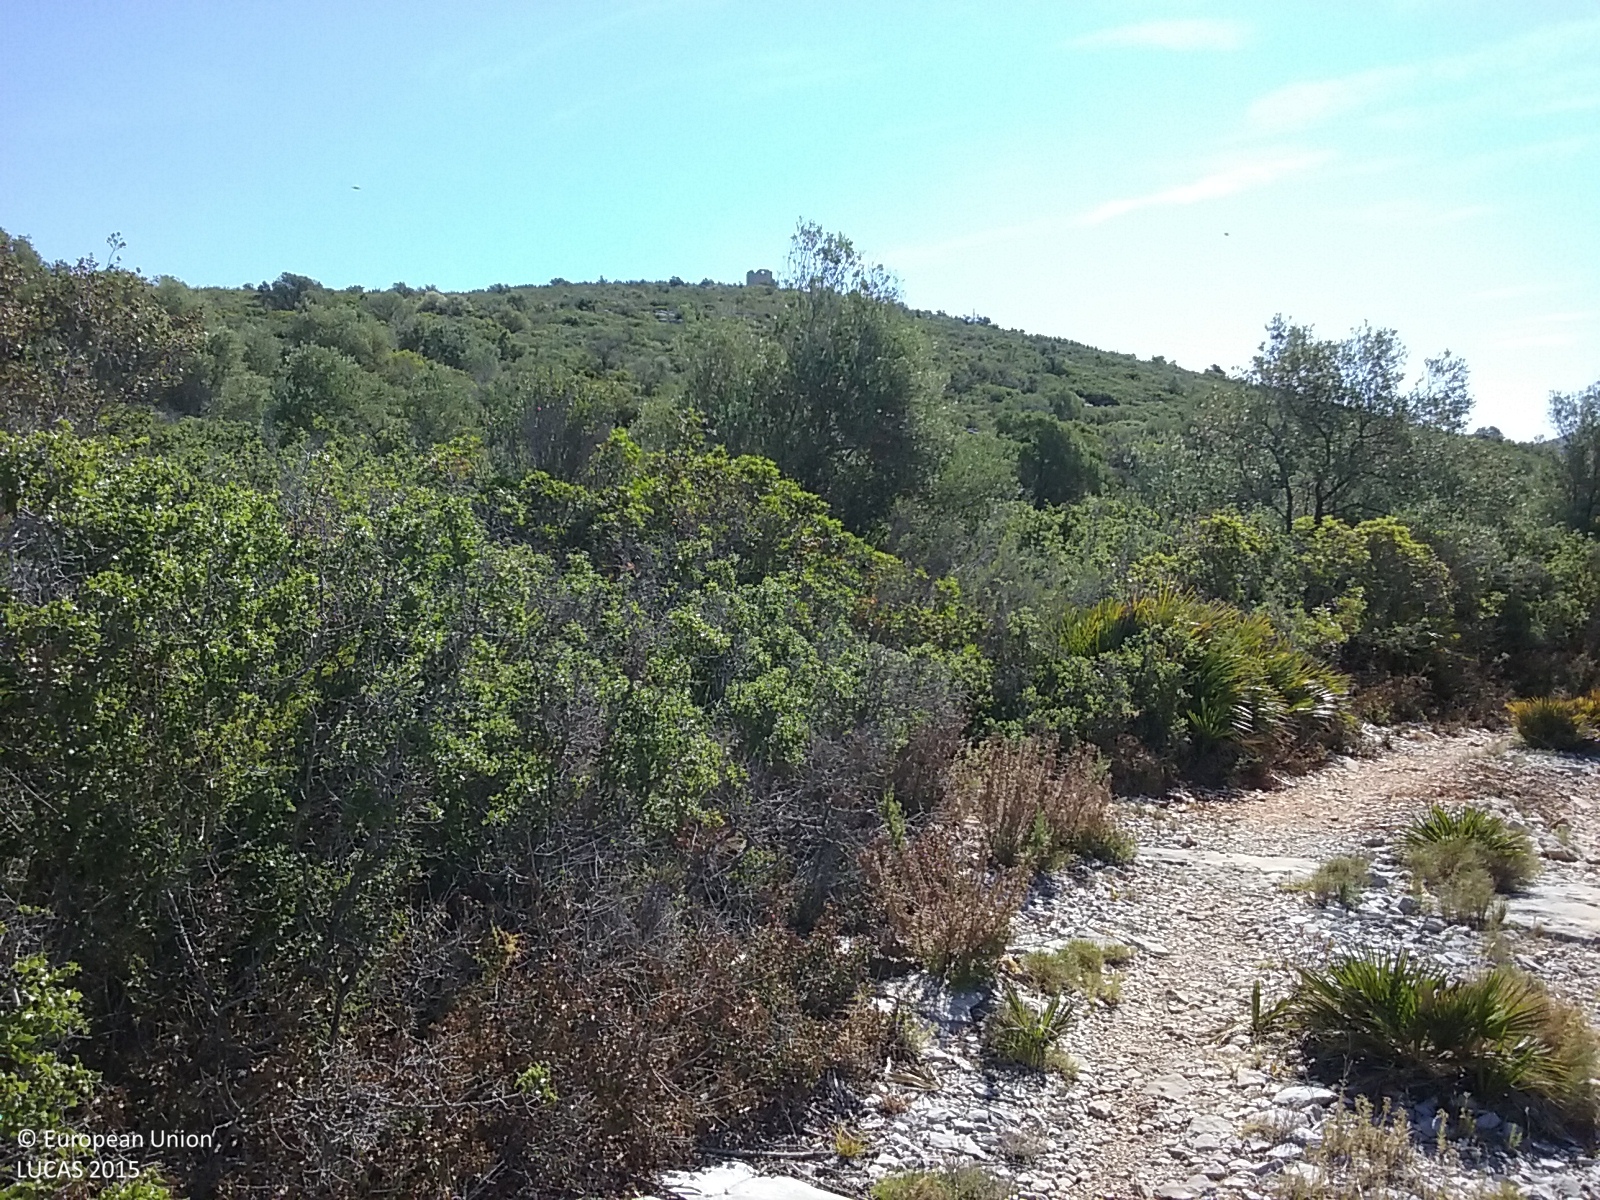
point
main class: Shrubland
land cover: Shrubland with sparse tree cover
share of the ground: > 75 %
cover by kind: shrubs 75 %, herbaceous plants 10 %, broadleaved forest trees 5 %
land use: Semi-natural and natural areas not in use
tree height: < 5 m
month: May
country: ES
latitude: 40.3687
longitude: 0.3045
